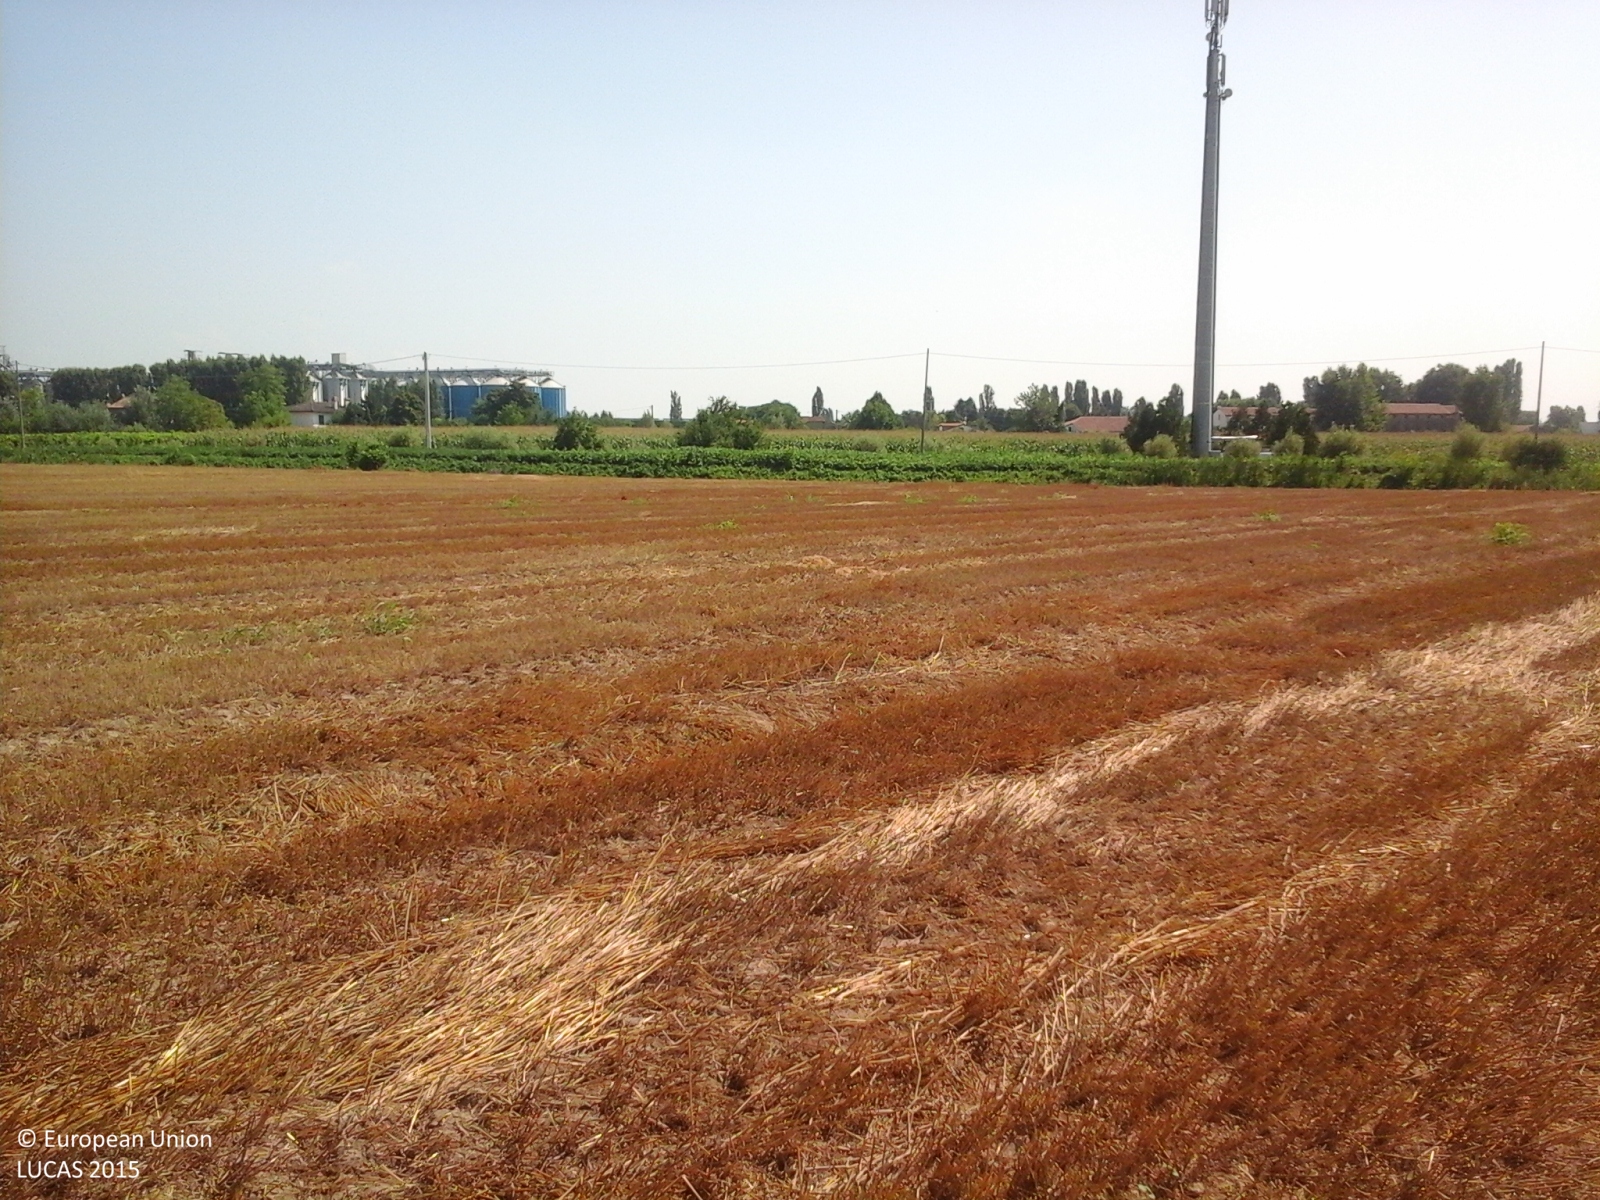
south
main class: Cropland
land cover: Common wheat
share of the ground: > 75 %
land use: Agriculture (excluding fallow land and kitchen gardens)
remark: Harvested field
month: July
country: IT
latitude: 45.2165
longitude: 11.9195
